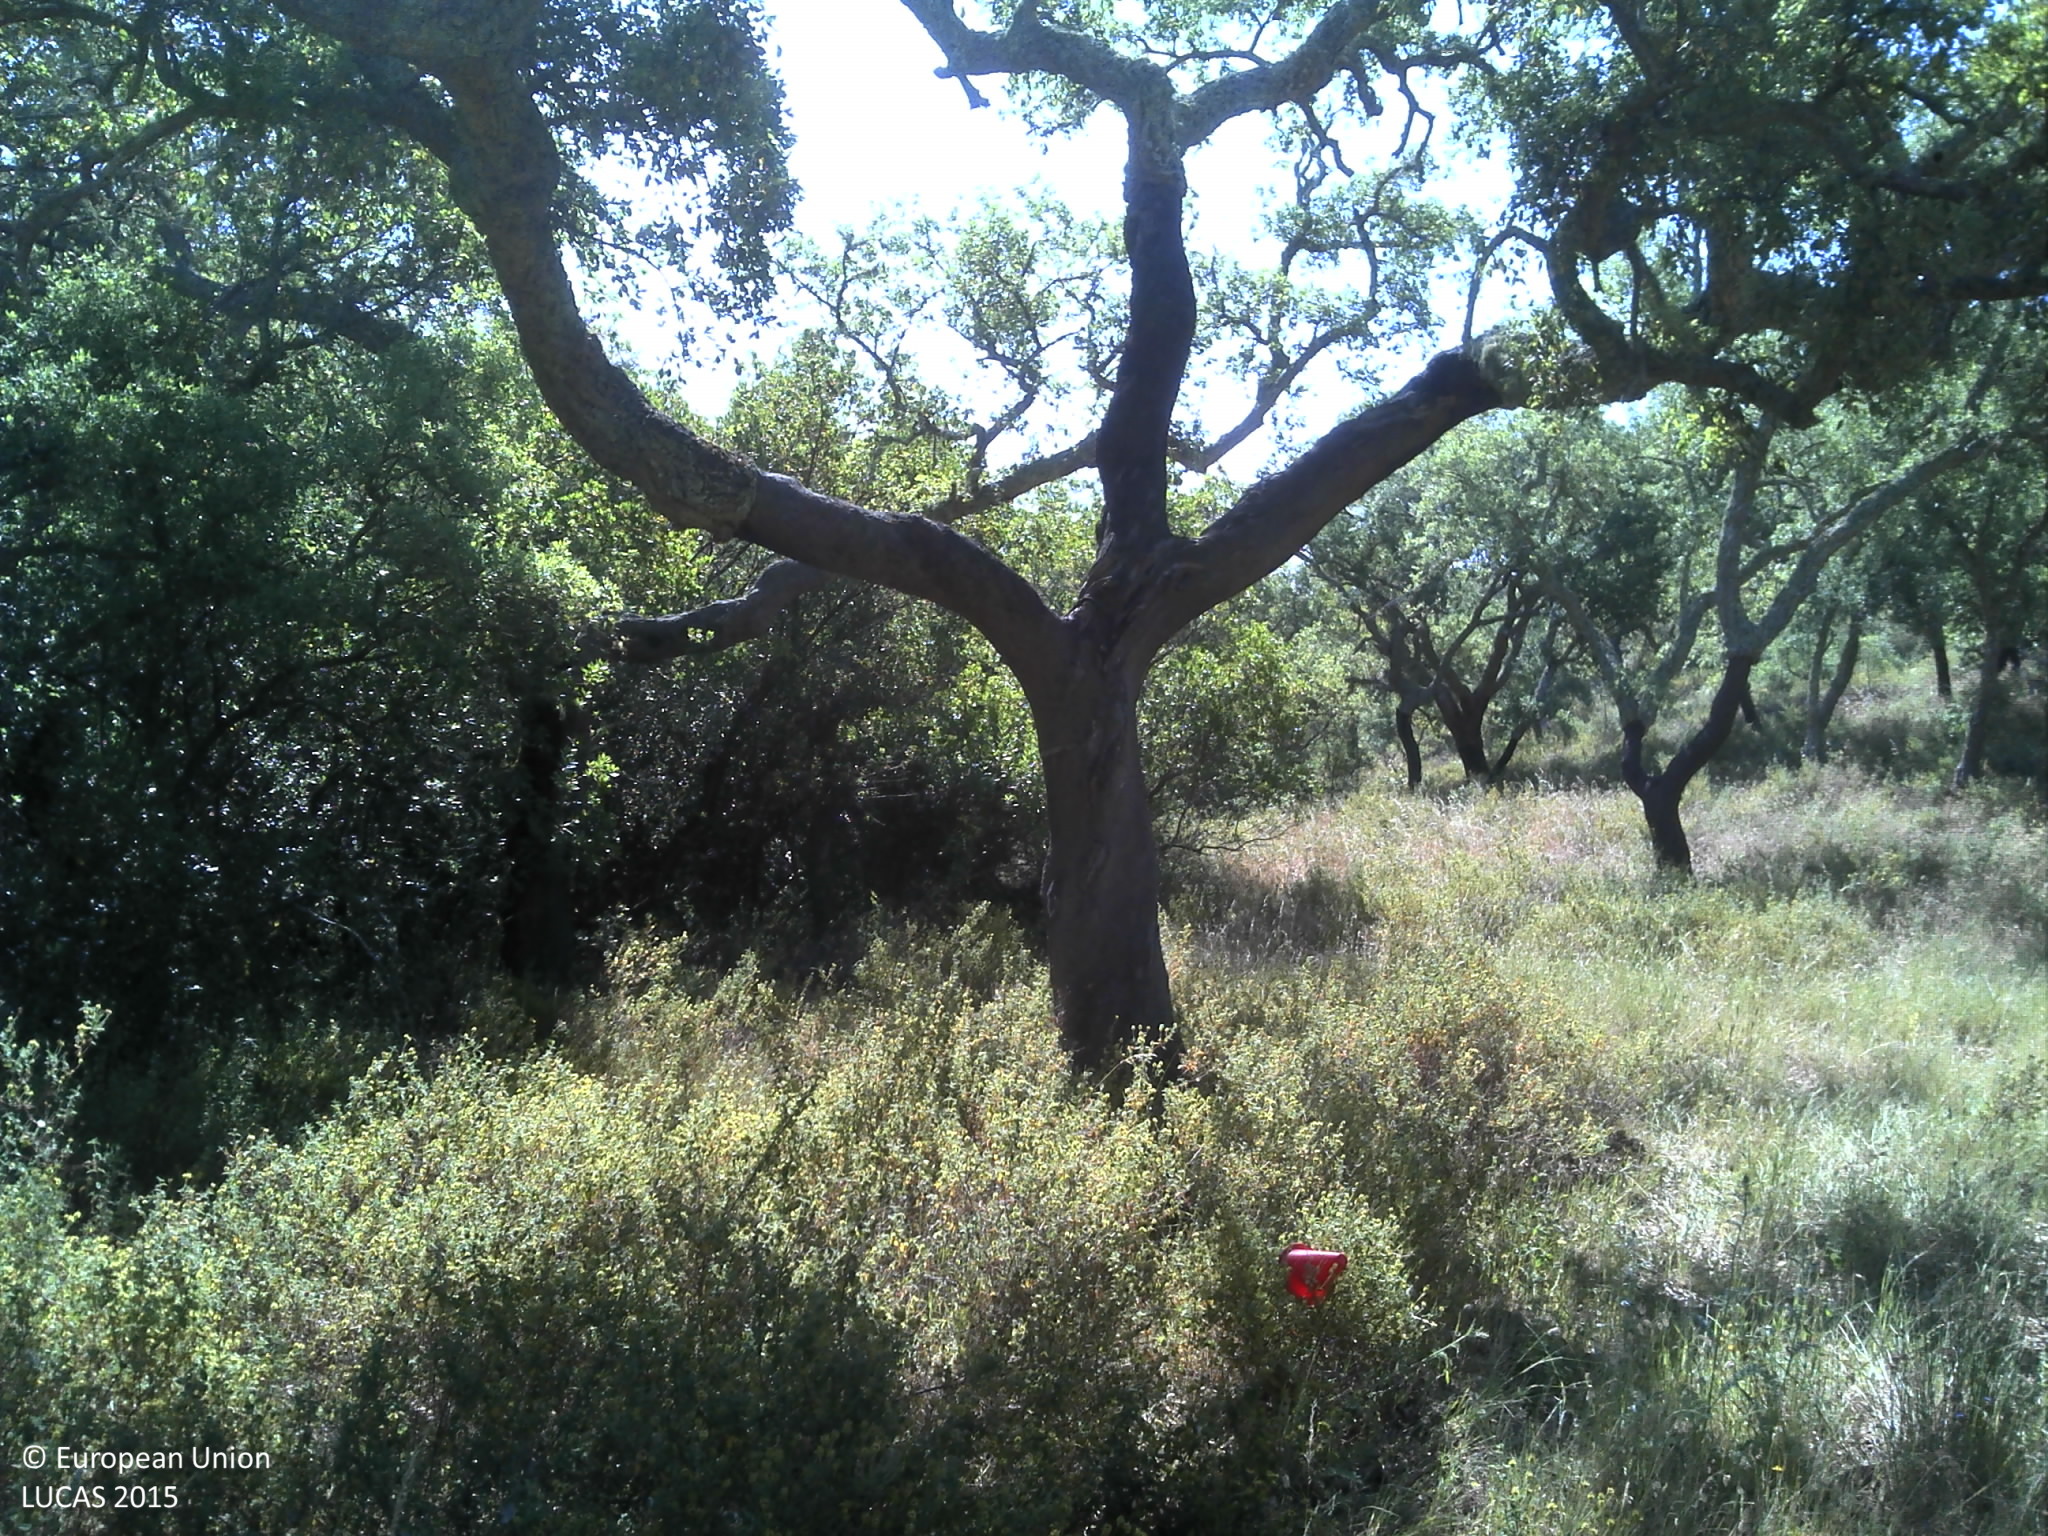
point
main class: Woodland
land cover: Broadleaved woodland
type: broadleaved evergreen forest
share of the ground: 25 - 50 %
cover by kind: shrubs 40 %, broadleaved forest trees 35 %, herbaceous plants 15 %, unconsolidated bare surface 10 %
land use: Forestry
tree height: > 5 m
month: May
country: PT
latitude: 38.0652
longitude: -8.5914
